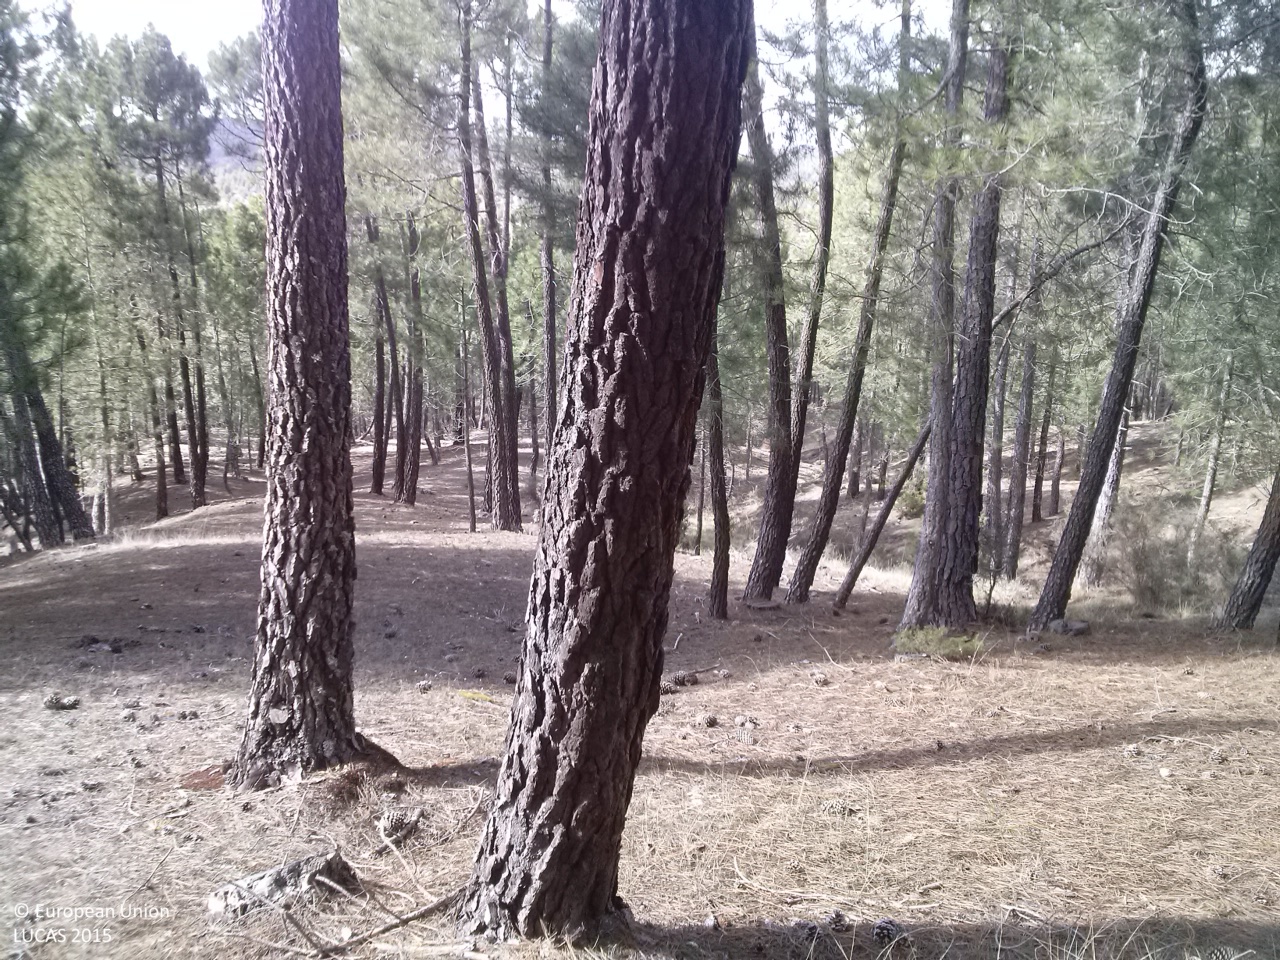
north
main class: Woodland
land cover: Pine dominated coniferous woodland
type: coniferous forest of the mediterranean region
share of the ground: 50 - 75 %
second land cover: Grassland without tree/shrub cover
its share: 10 - 25 %
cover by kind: coniferous forest trees 65 %, herbaceous plants 25 %, unconsolidated bare surface 10 %
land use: Forestry
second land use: Agriculture (excluding fallow land and kitchen gardens)
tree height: > 5 m
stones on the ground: < 10 %
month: April
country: ES
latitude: 40.1376
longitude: -1.6436
